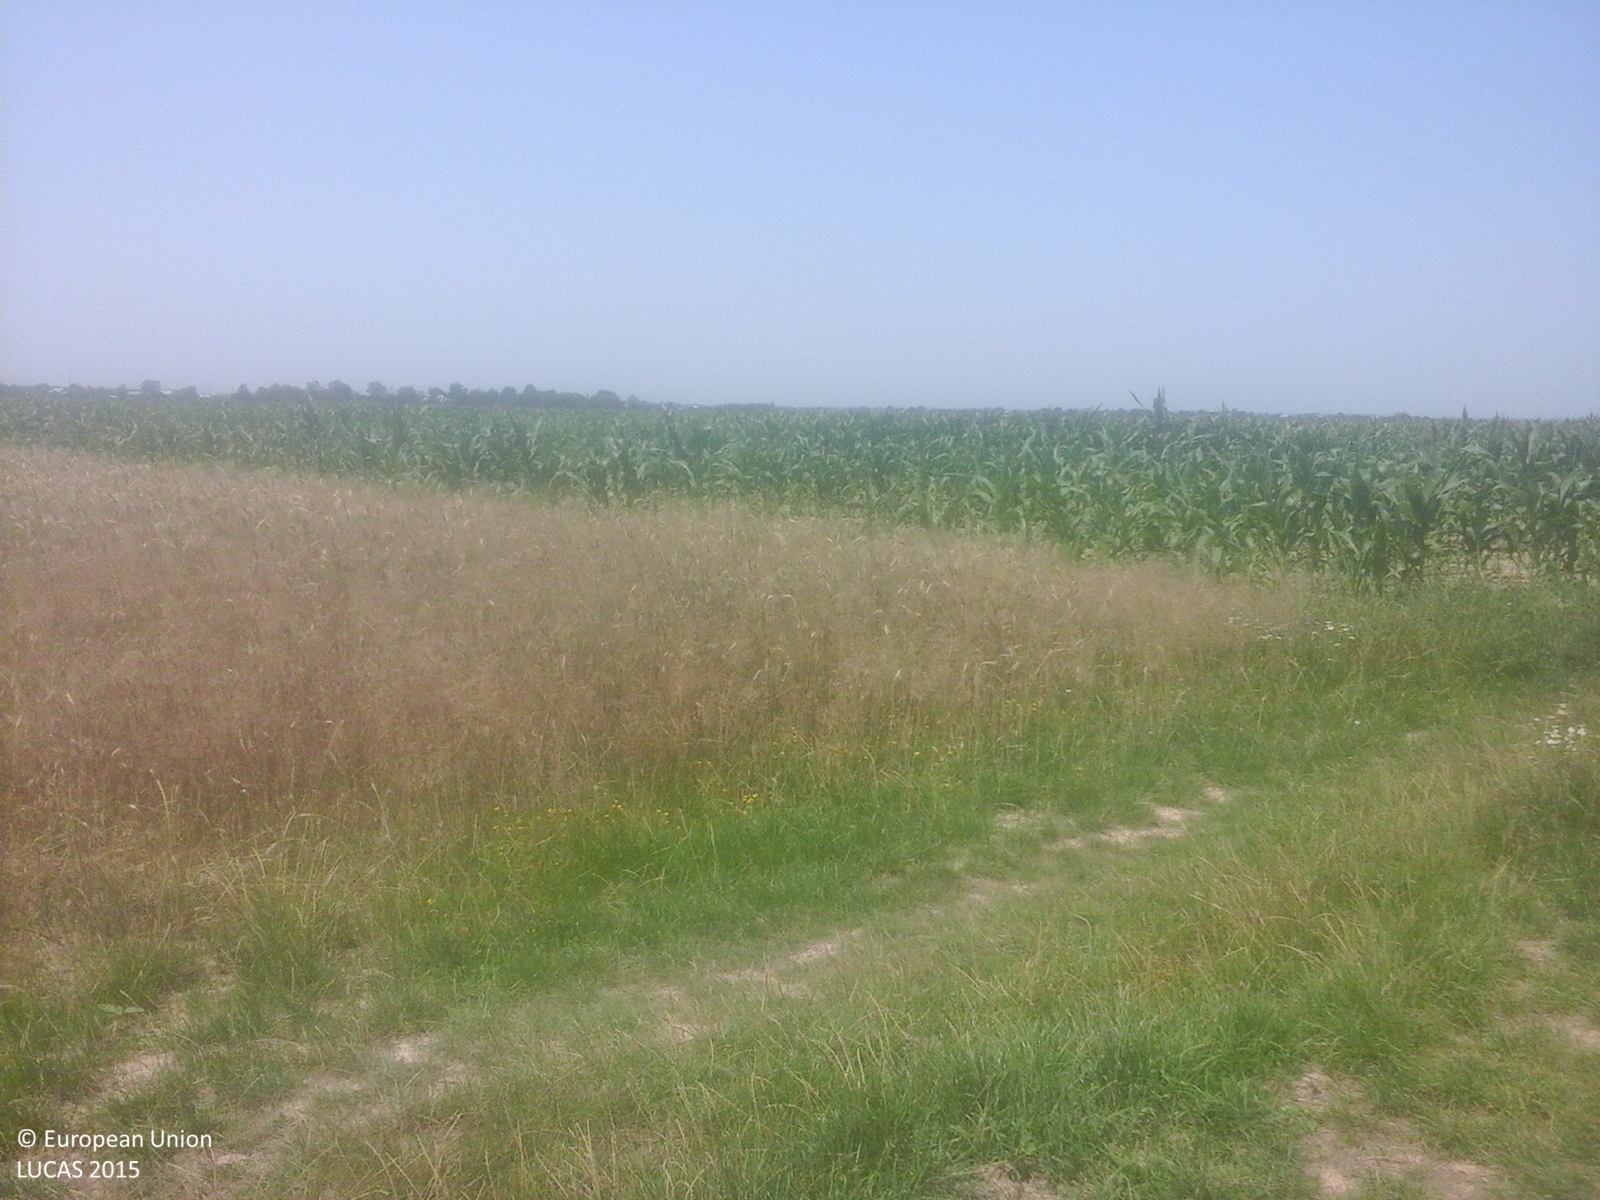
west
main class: Cropland
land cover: Maize
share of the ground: > 75 %
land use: Agriculture (excluding fallow land and kitchen gardens)
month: July
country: RO
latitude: 44.7194
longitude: 24.9923
